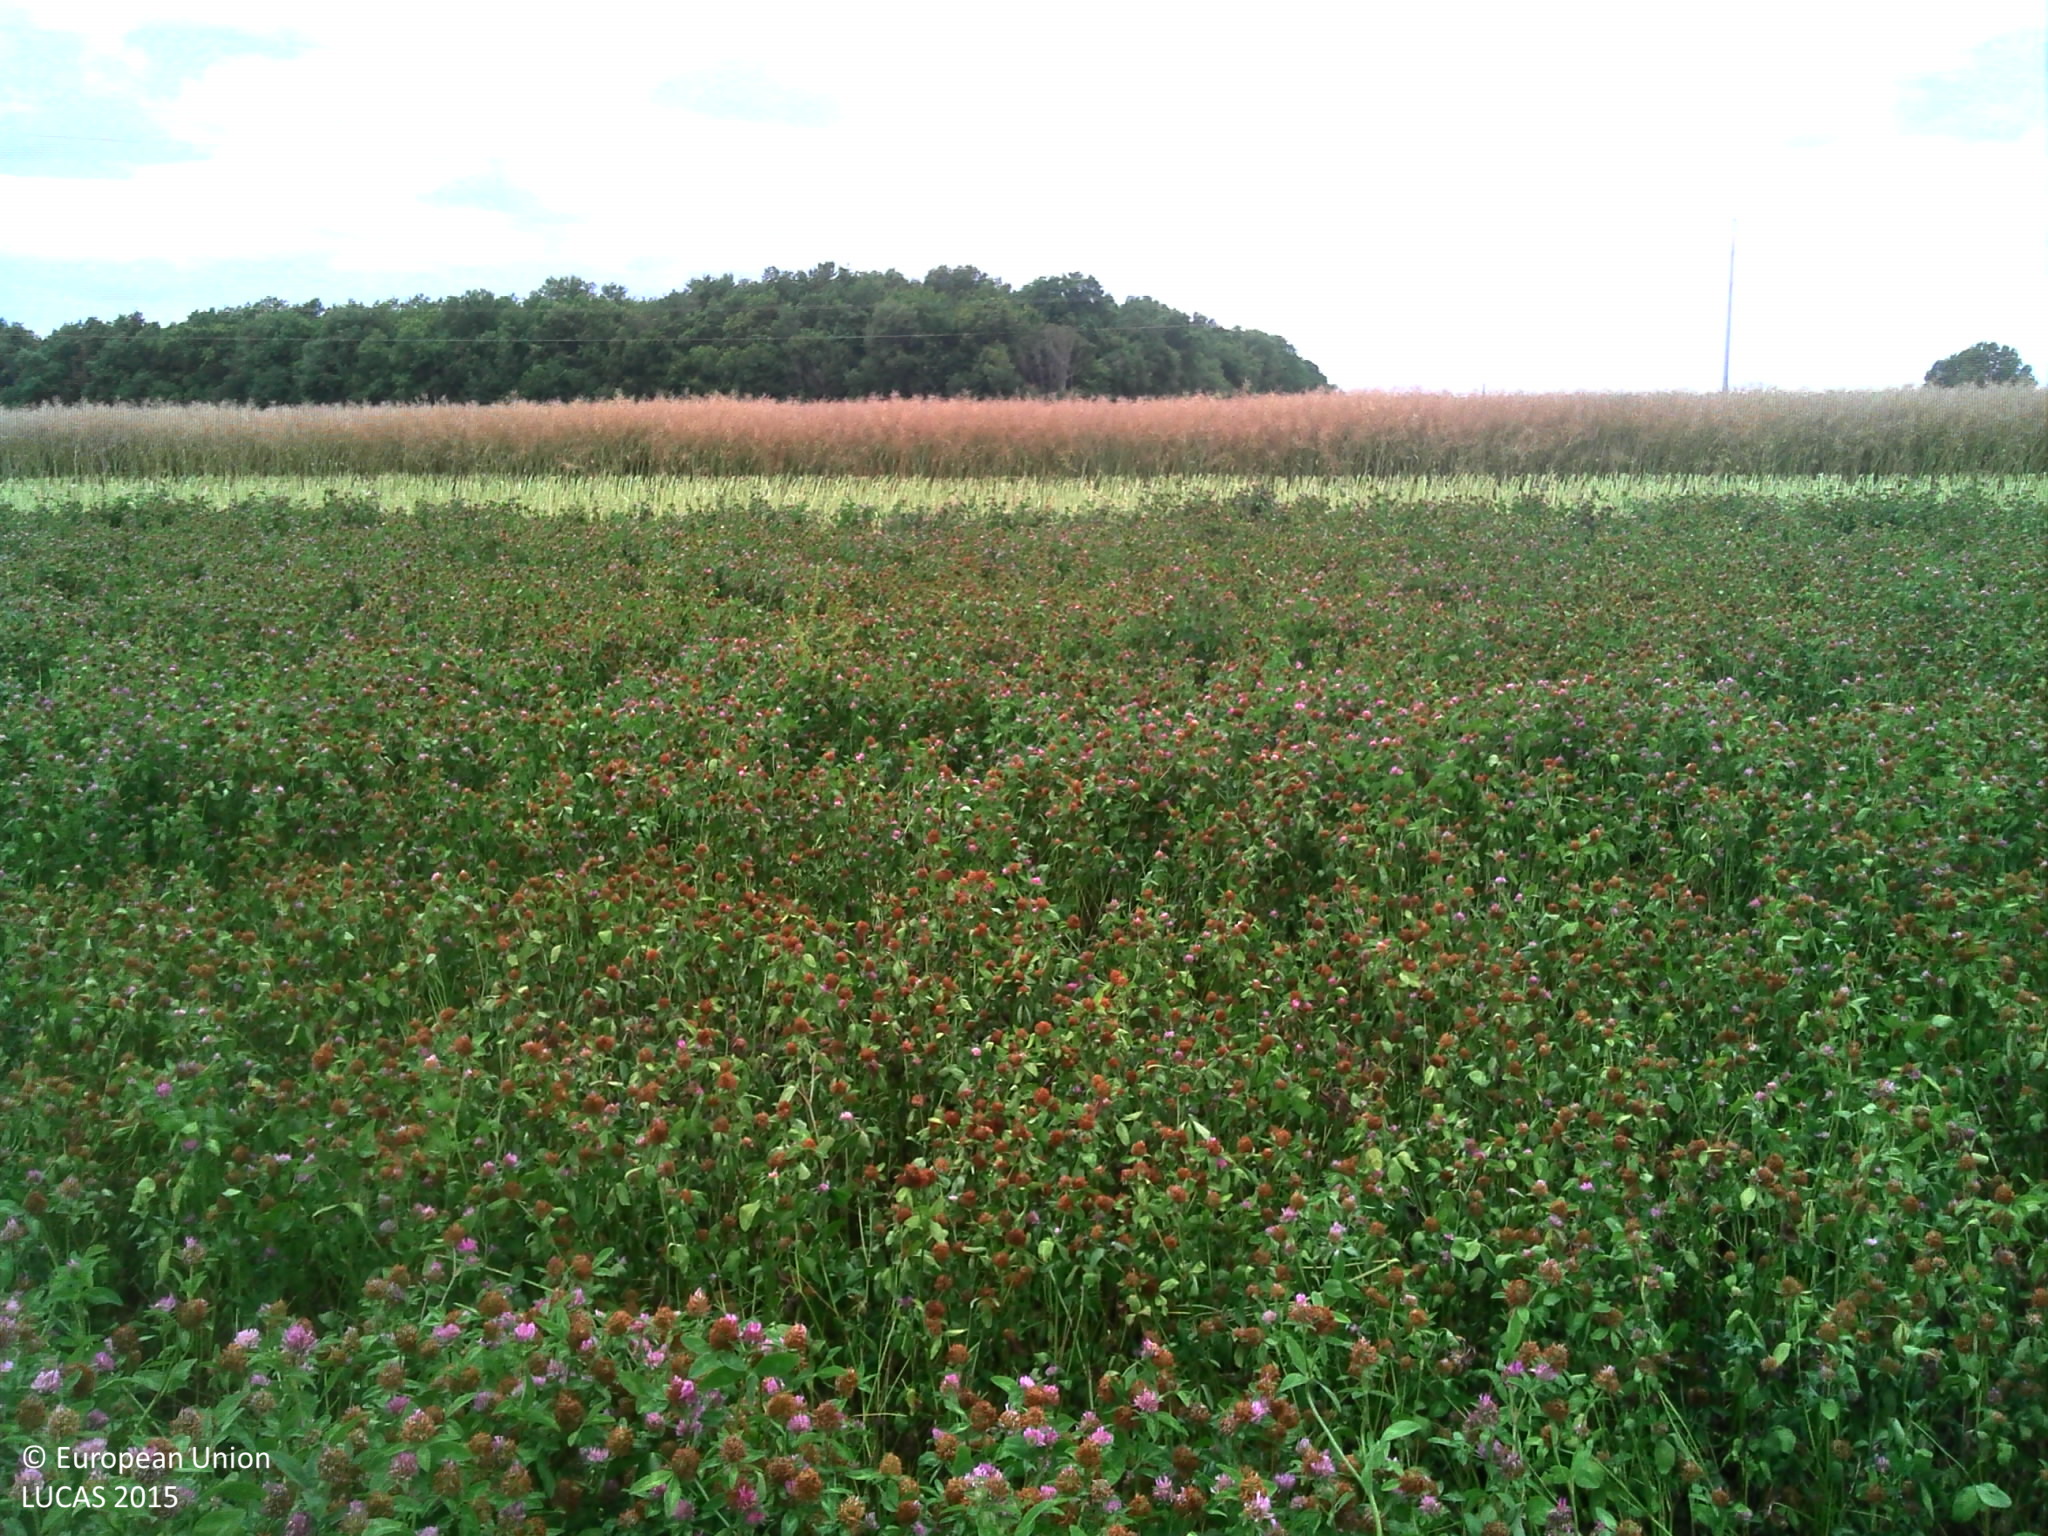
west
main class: Cropland
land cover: Clovers
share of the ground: > 75 %
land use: Agriculture (excluding fallow land and kitchen gardens)
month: July
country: FR
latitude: 47.2516
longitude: 0.7189
